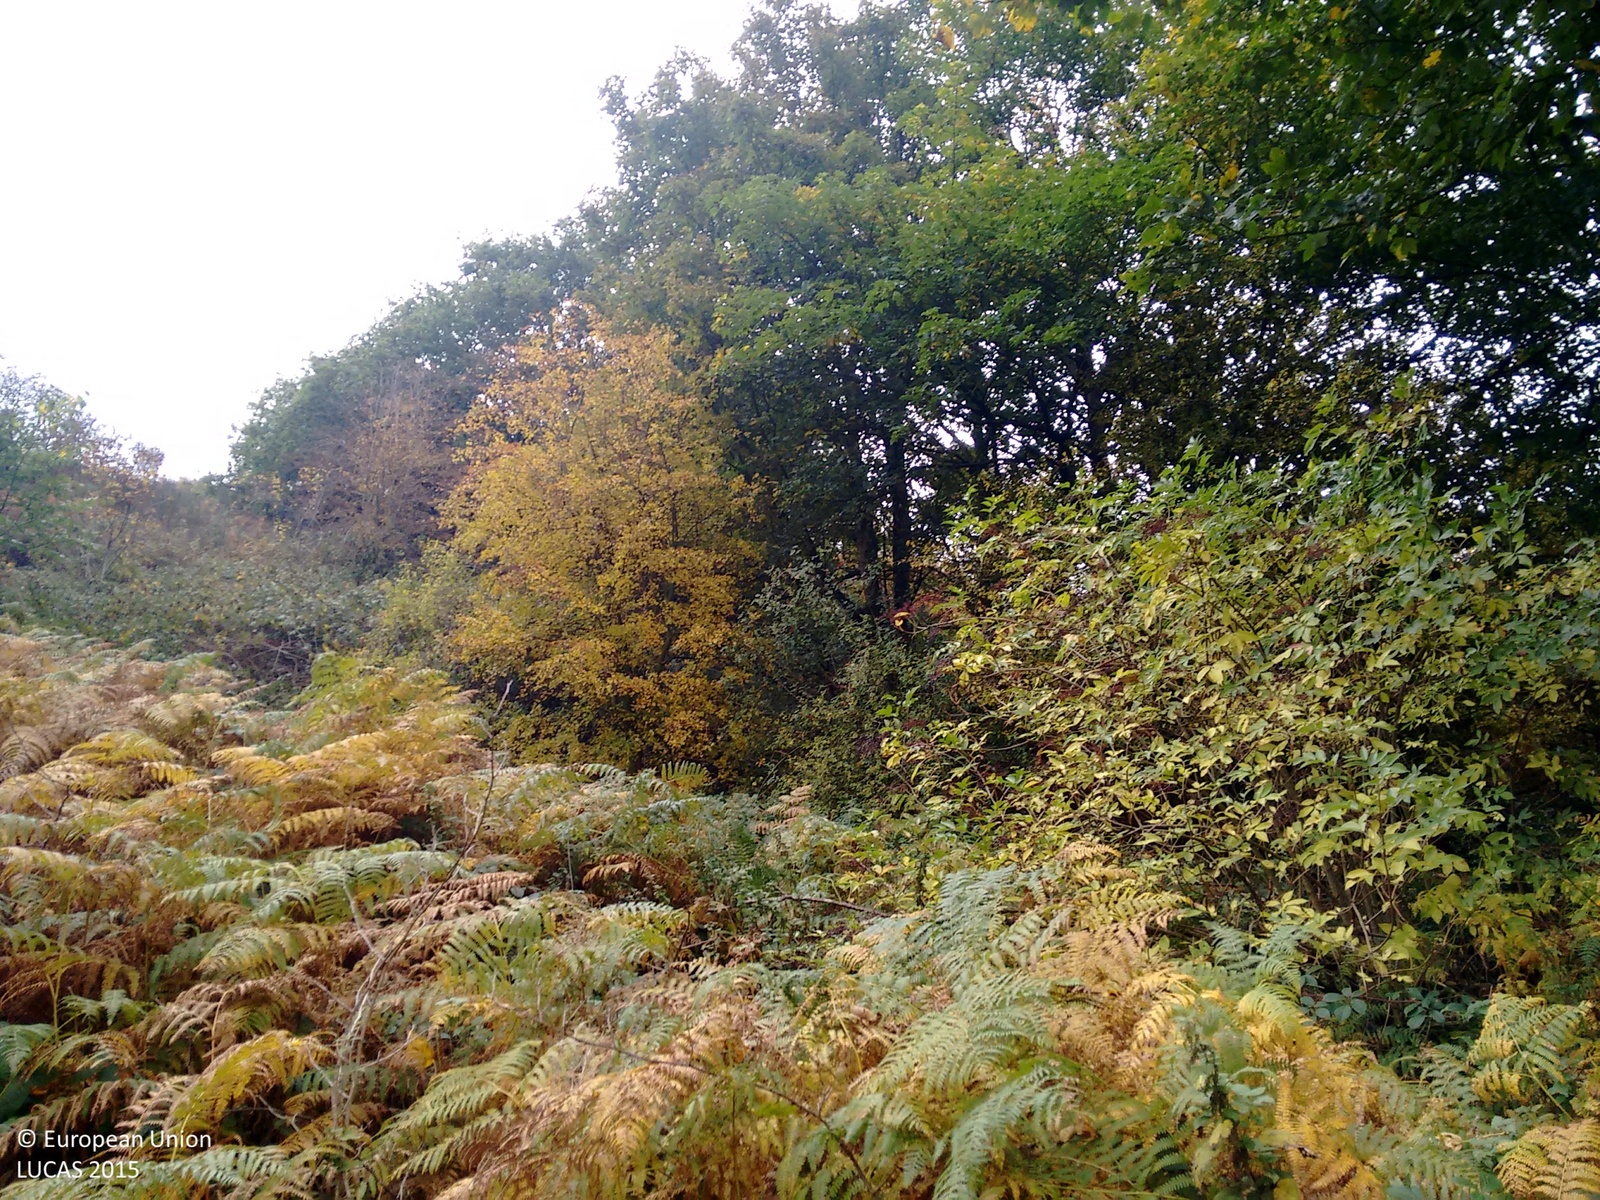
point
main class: Woodland
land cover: Broadleaved woodland
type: mesophytic deciduous forest
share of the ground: > 75 %
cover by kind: broadleaved forest trees 60 %, shrubs 20 %, herbaceous plants 20 %
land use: Semi-natural and natural areas not in use
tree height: > 5 m
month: October
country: GB
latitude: 52.5551
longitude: -2.8000
